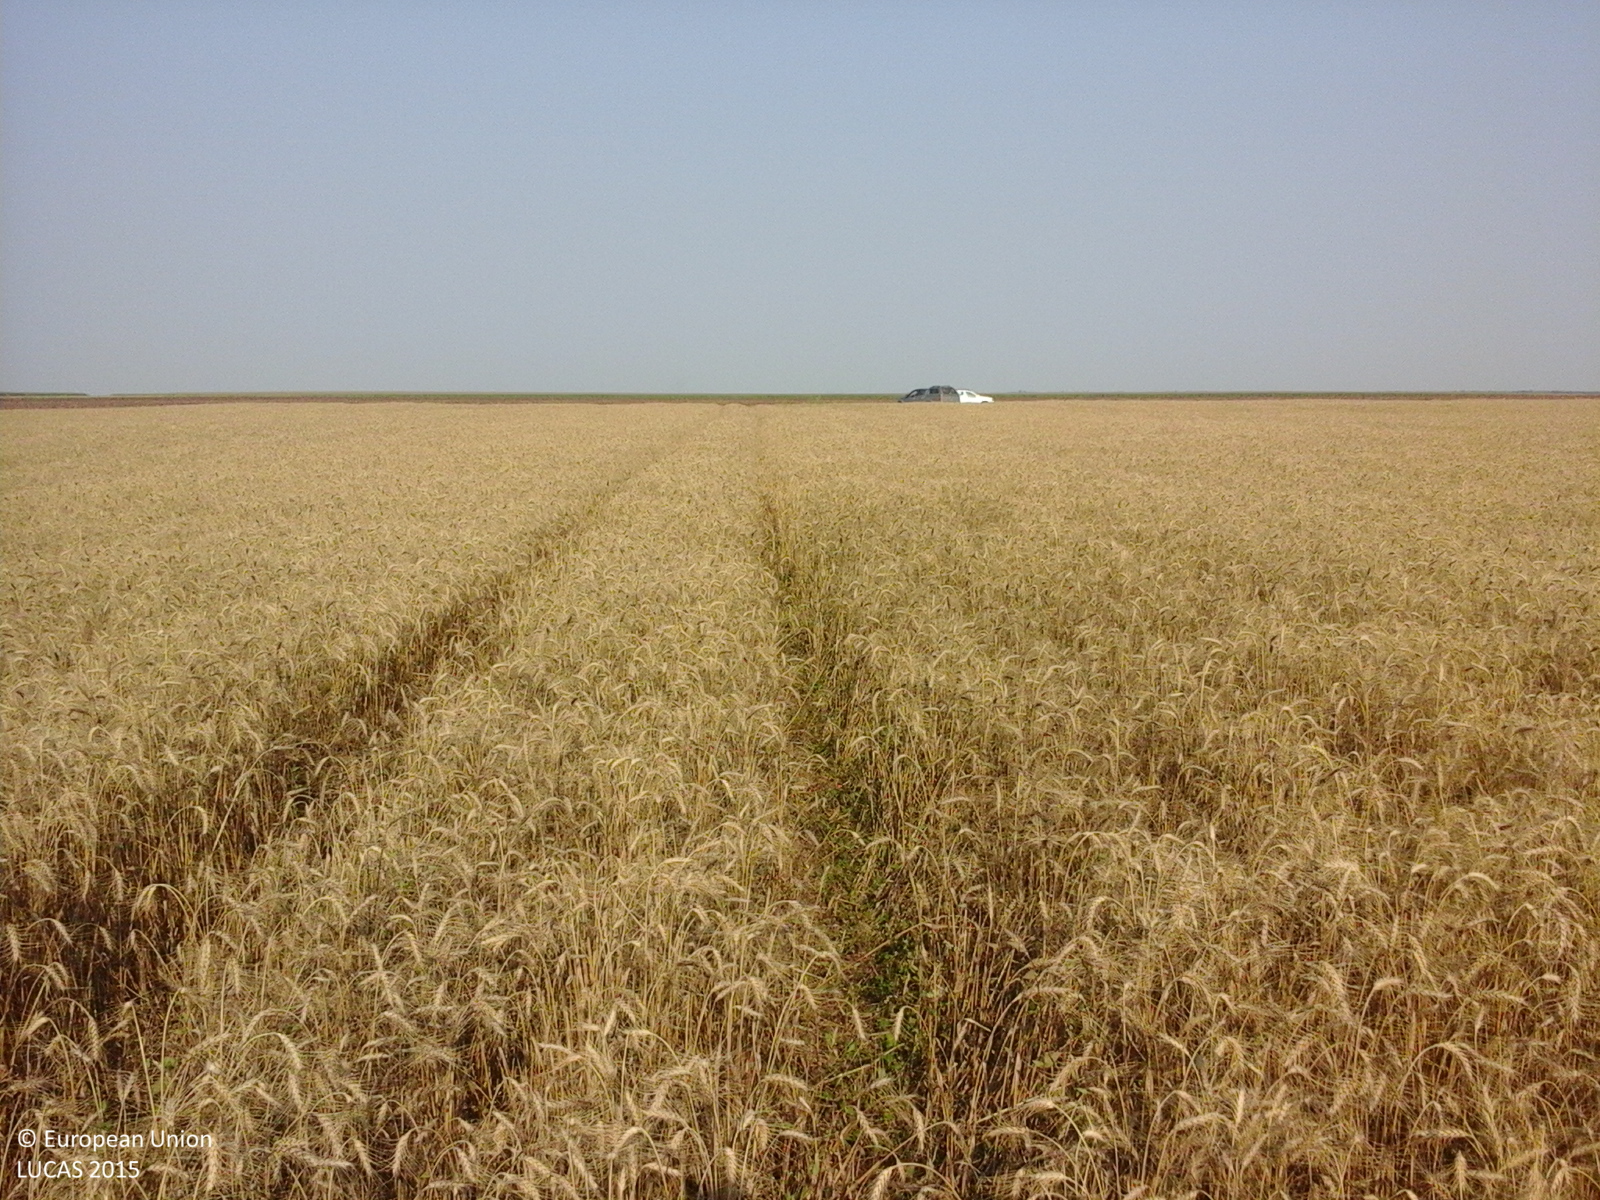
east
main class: Cropland
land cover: Common wheat
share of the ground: > 75 %
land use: Agriculture (excluding fallow land and kitchen gardens)
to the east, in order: Common wheat; Tracks; Other bare soil
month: July
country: RO
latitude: 44.4650
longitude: 26.6480
